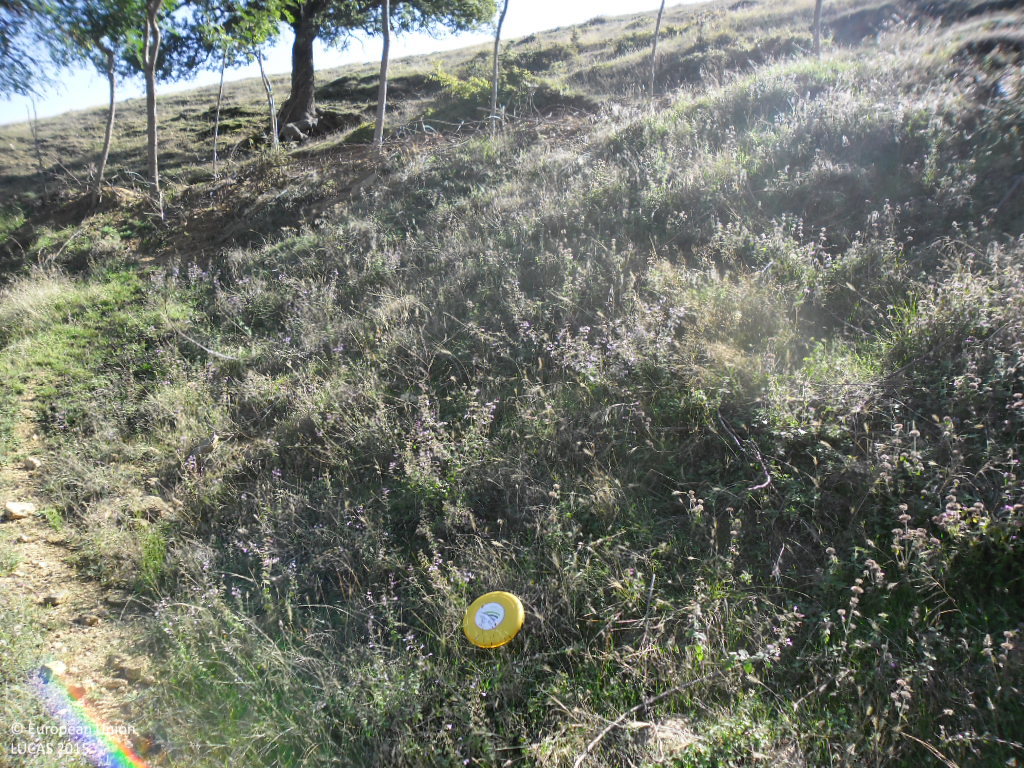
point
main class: Grassland
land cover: Grassland with sparse tree/shrub cover
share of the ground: > 75 %
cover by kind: herbaceous plants 90 %, broadleaved forest trees 5 %, shrubs 5 %
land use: Agriculture (excluding fallow land and kitchen gardens)
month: October
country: BG
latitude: 41.4463
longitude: 23.0040
